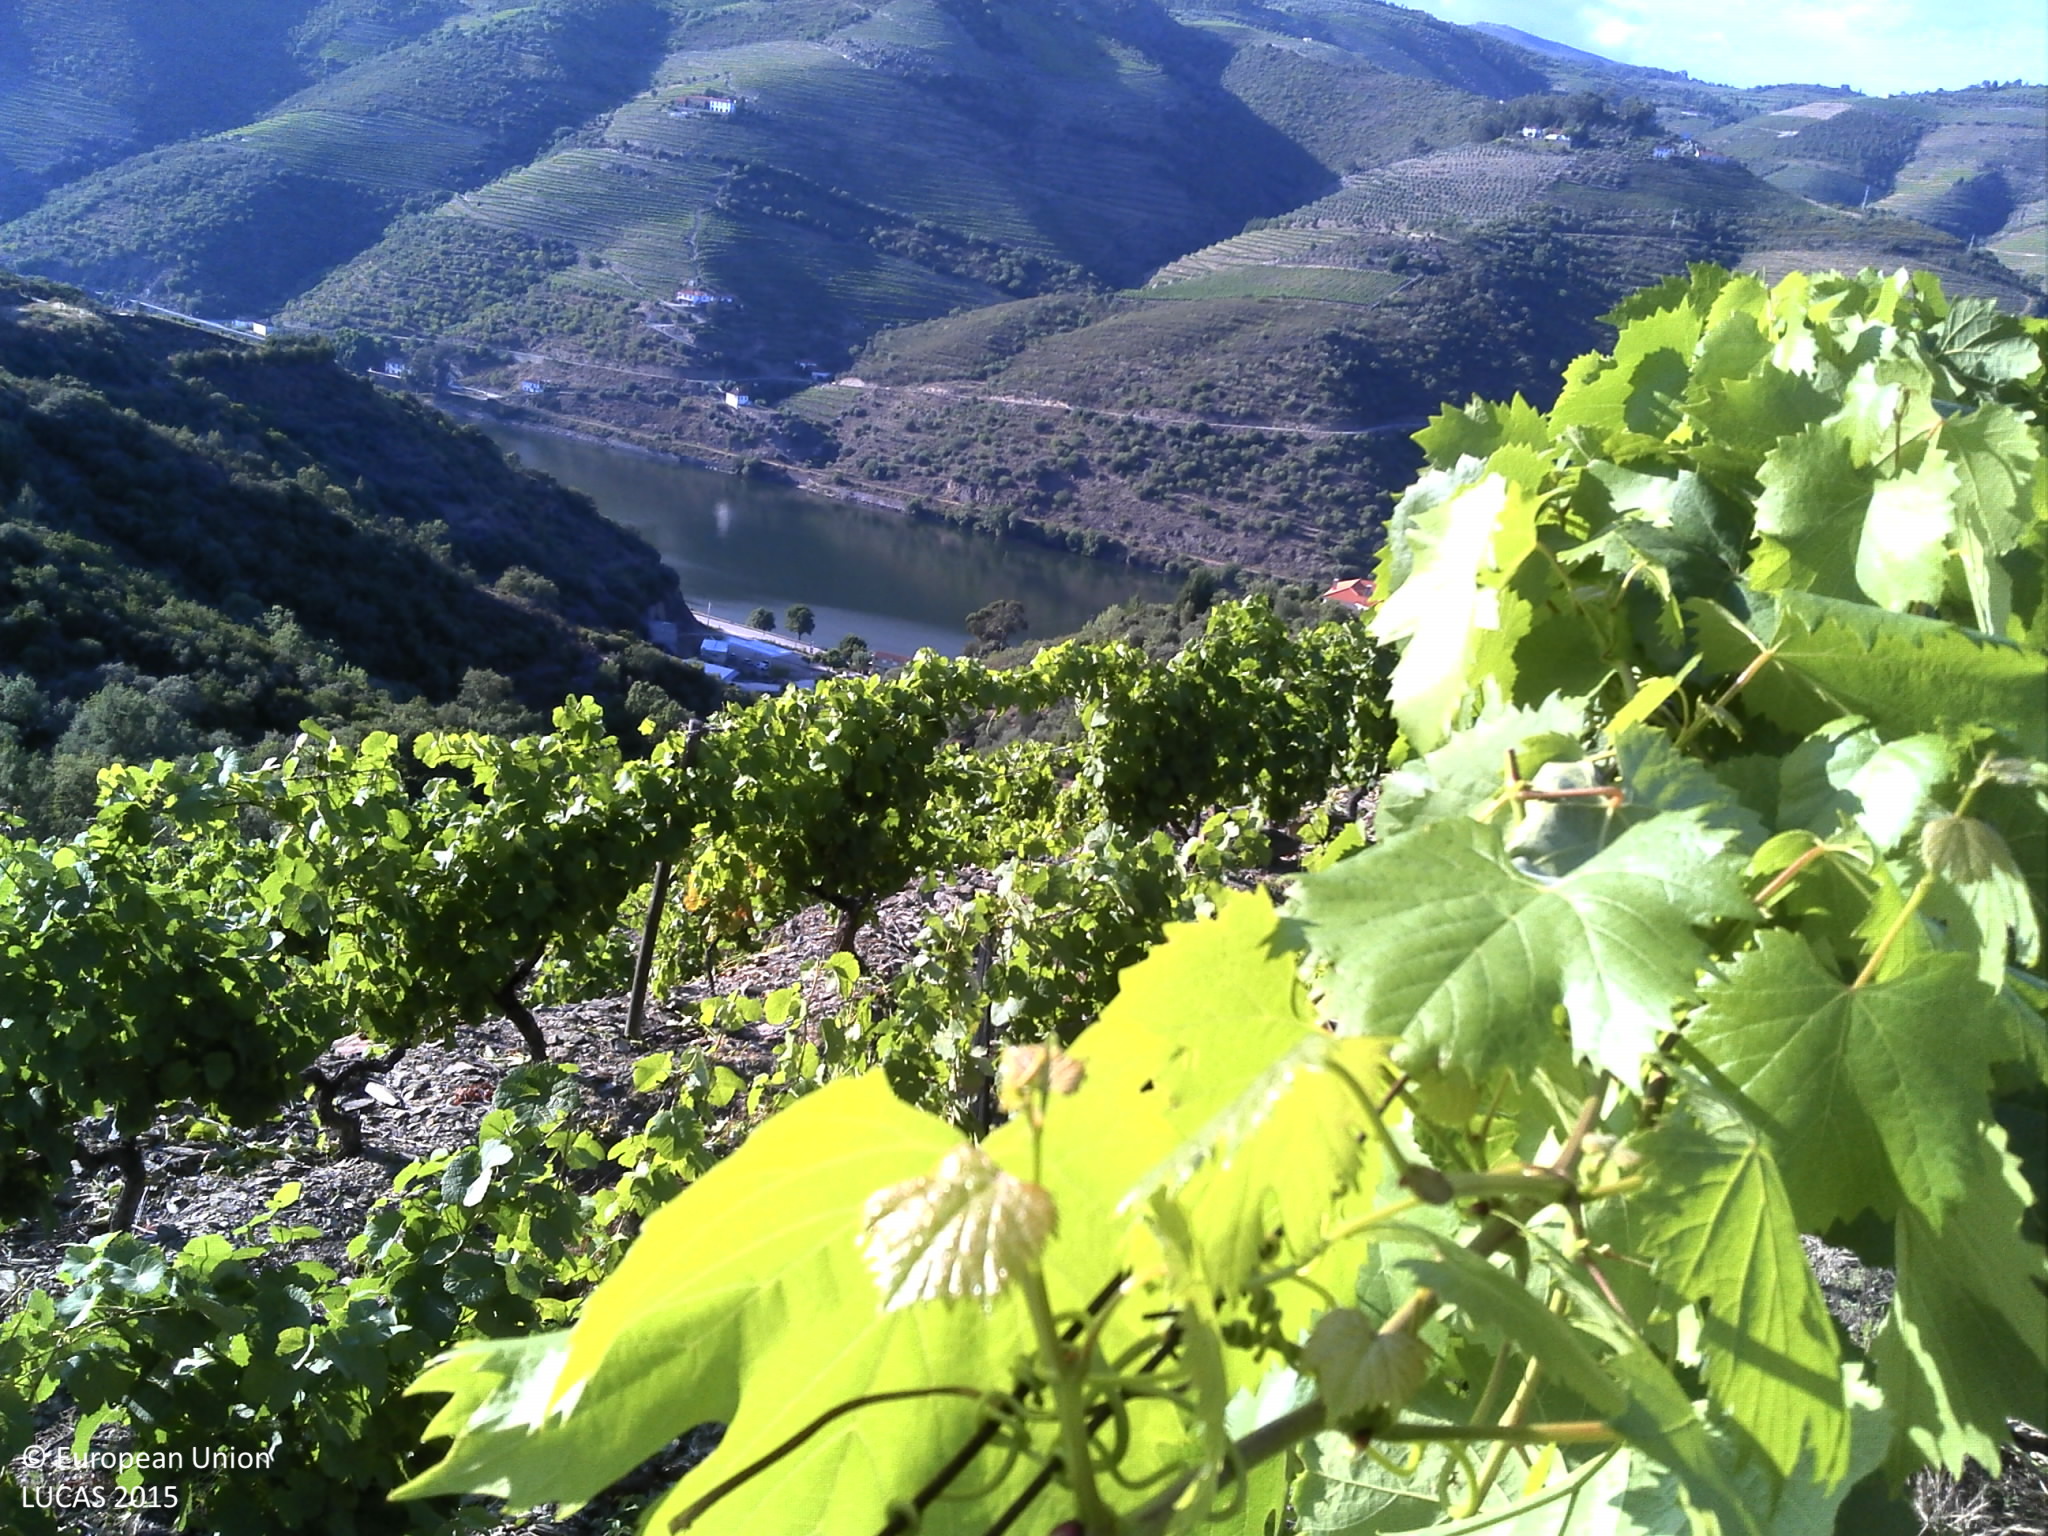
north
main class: Cropland
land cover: Vineyards
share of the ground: 10 - 25 %
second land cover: Grassland without tree/shrub cover
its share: 25 - 50 %
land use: Agriculture (excluding fallow land and kitchen gardens)
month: June
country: PT
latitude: 41.1529
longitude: -7.6053
